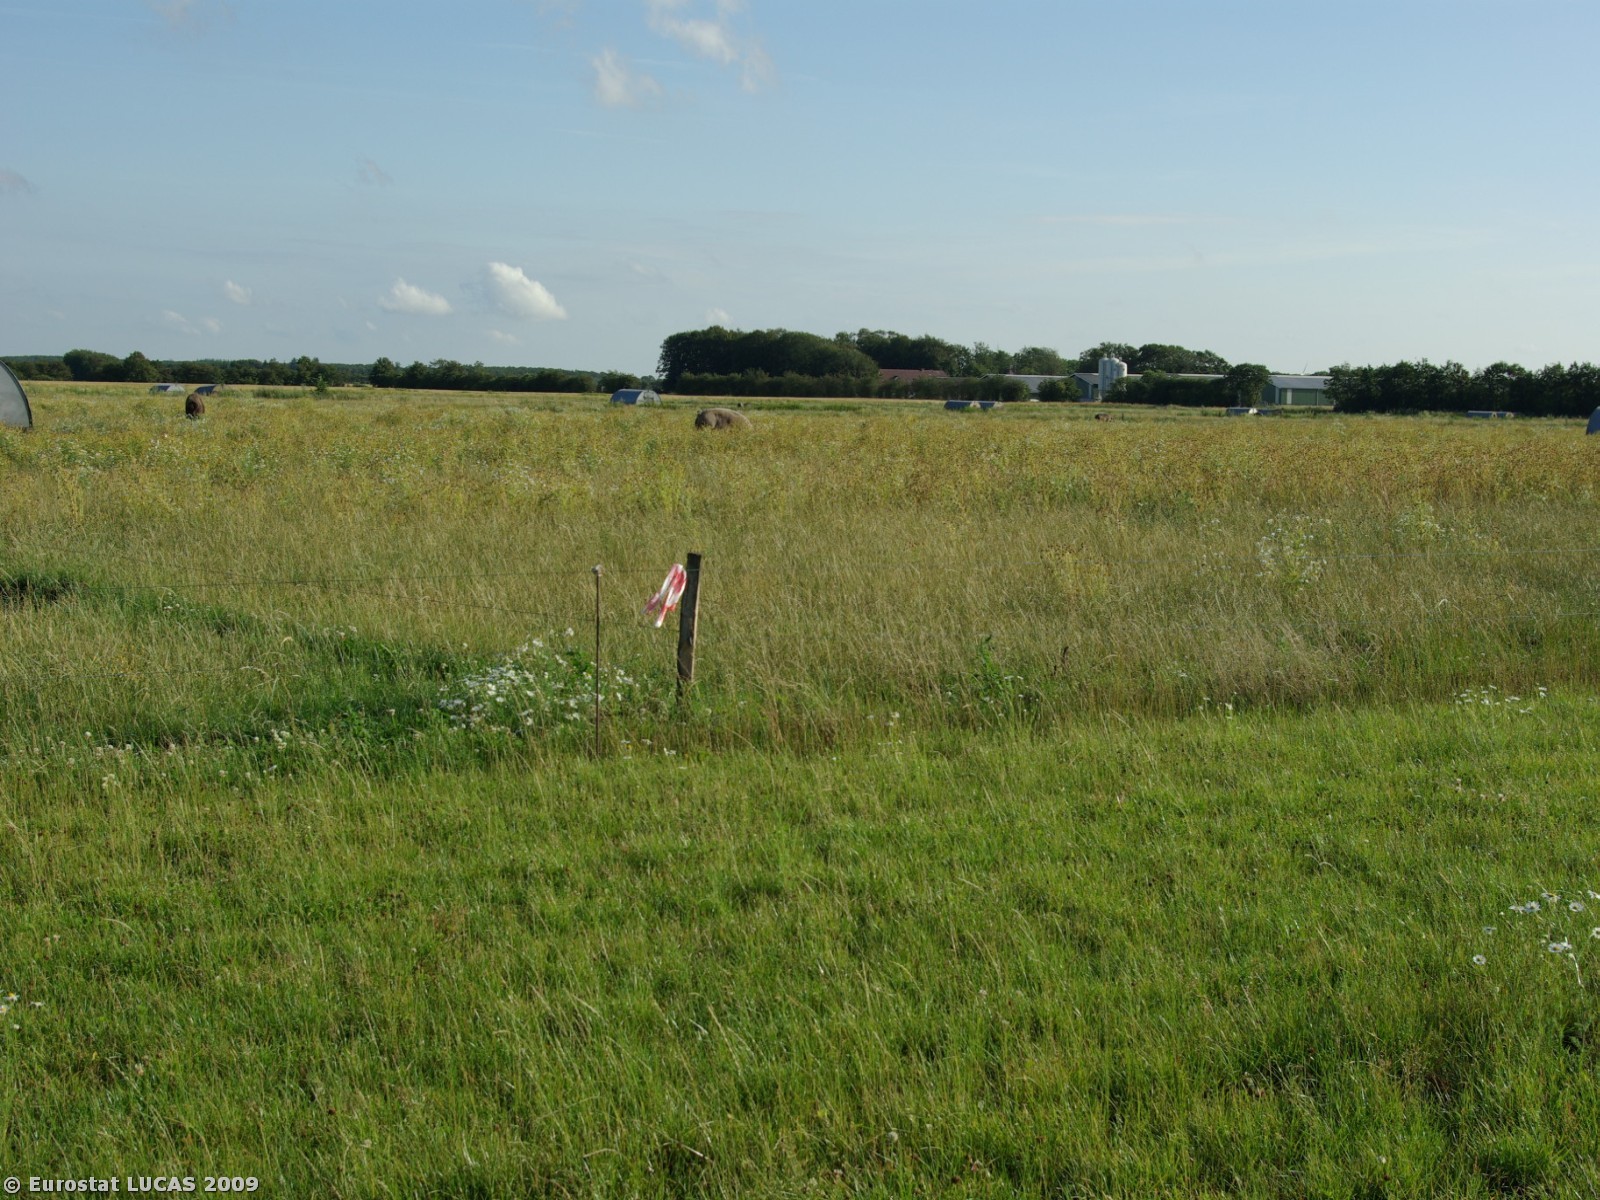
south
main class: Grassland
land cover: Grassland without tree/shrub cover
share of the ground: > 75 %
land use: Agriculture (excluding fallow land and kitchen gardens)
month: July
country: DK
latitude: 55.1763
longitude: 8.8861
